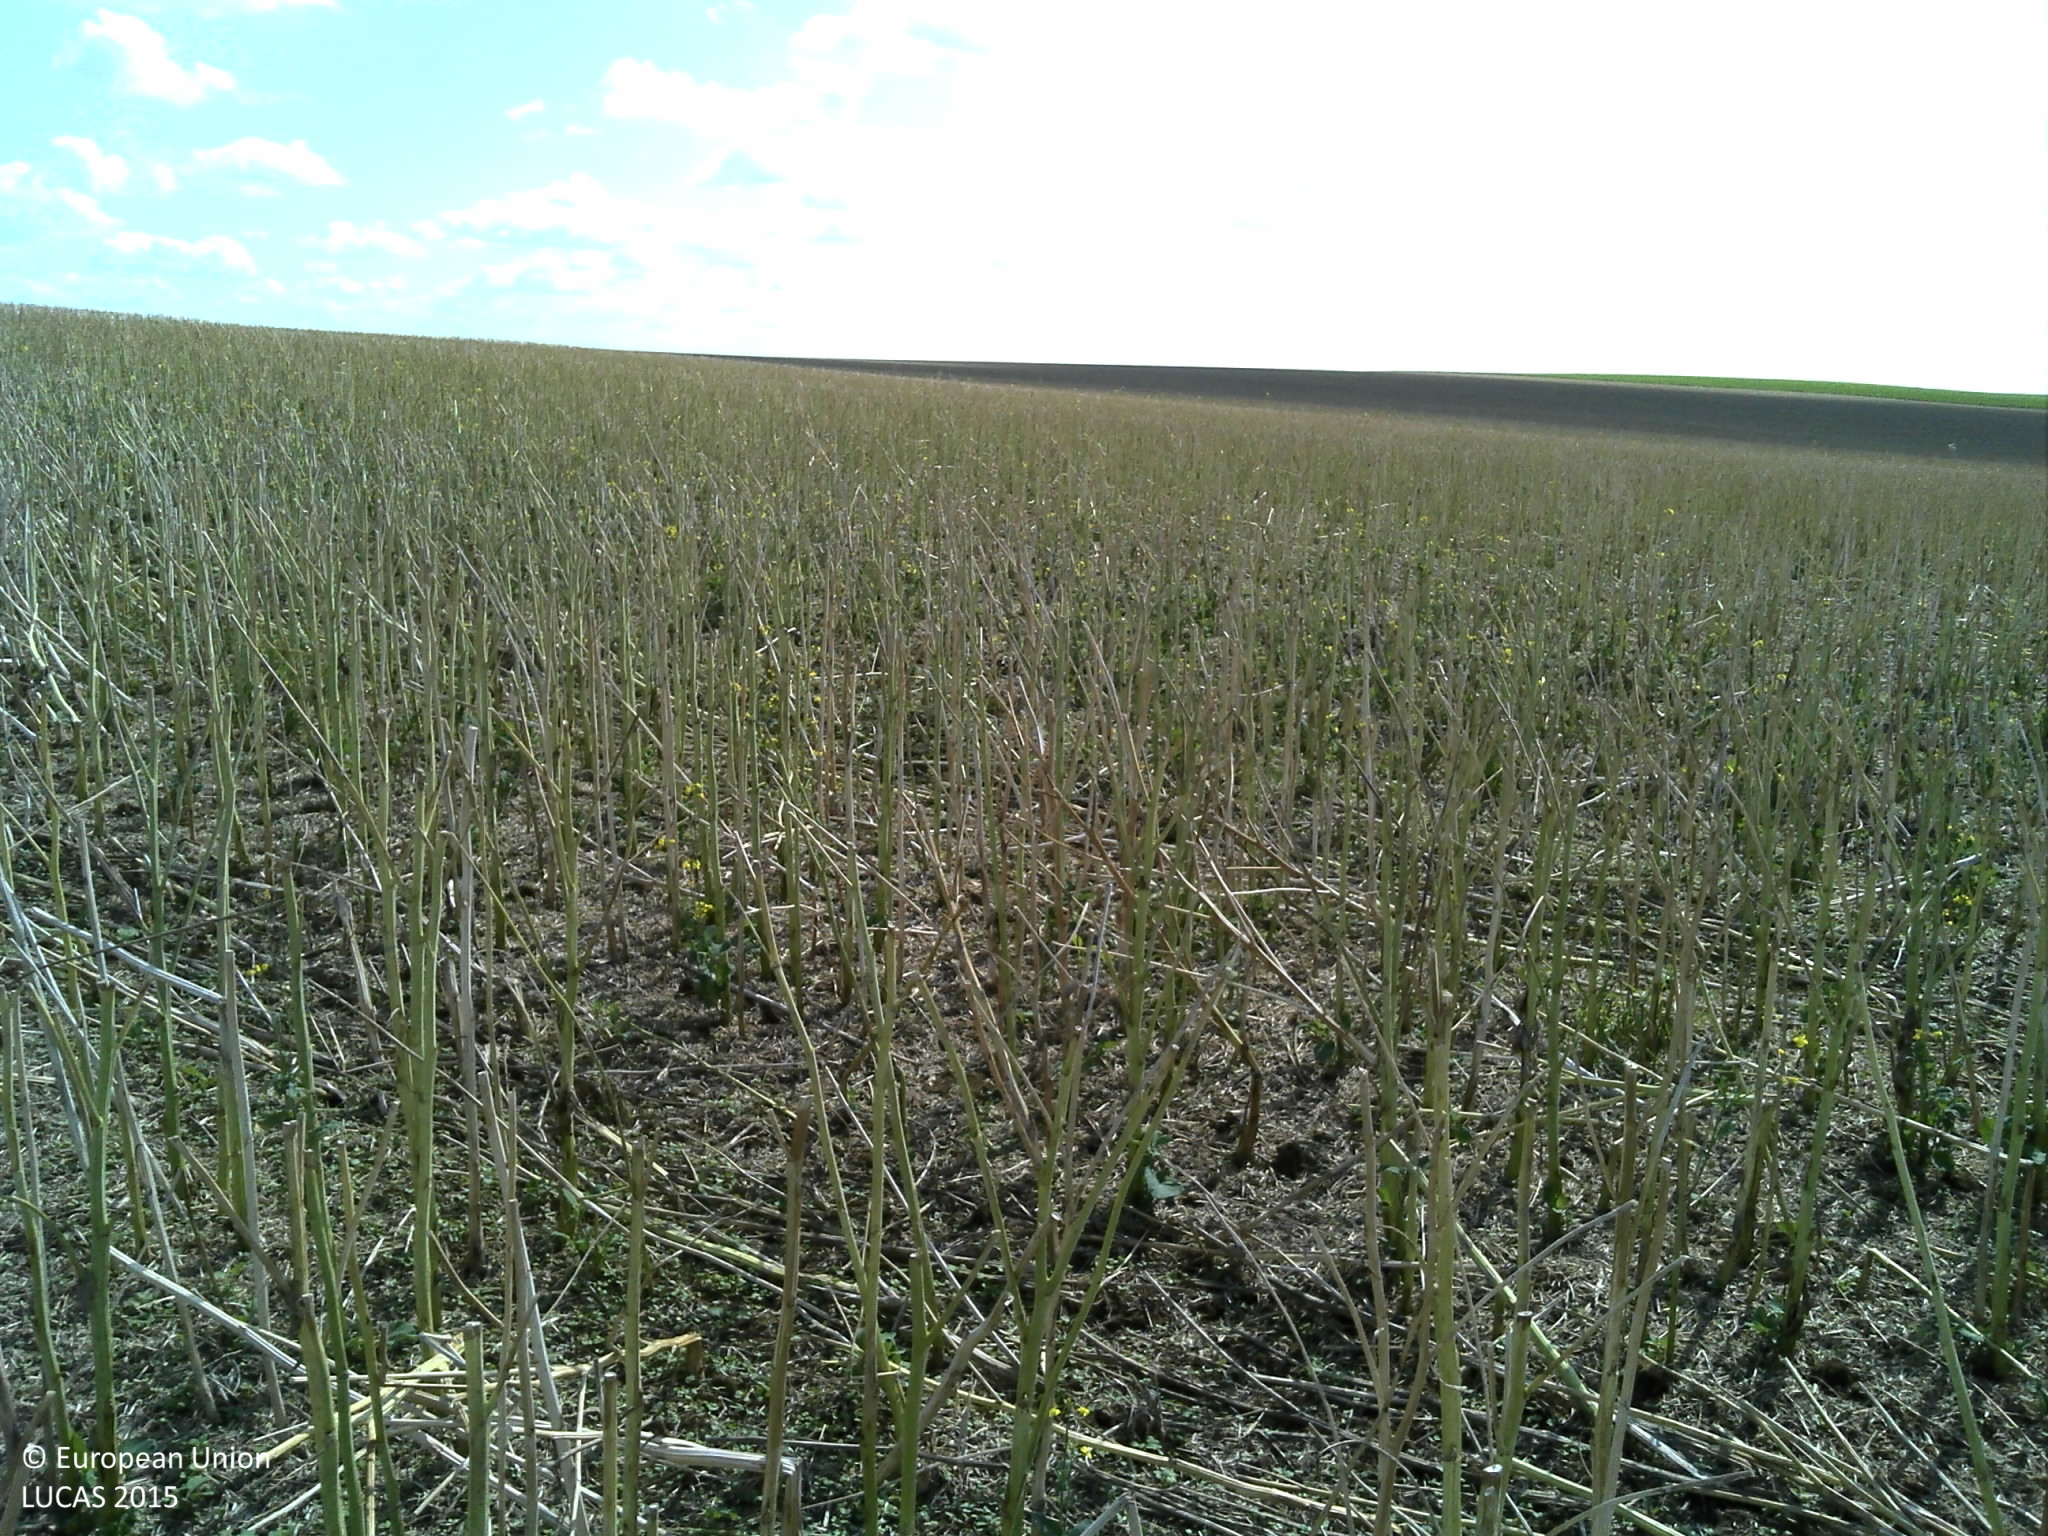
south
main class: Cropland
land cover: Rape and turnip rape
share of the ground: 10 - 25 %
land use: Agriculture (excluding fallow land and kitchen gardens)
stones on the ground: < 10 %
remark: Harvested field
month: August
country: FR
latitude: 49.9420
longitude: 3.1492
